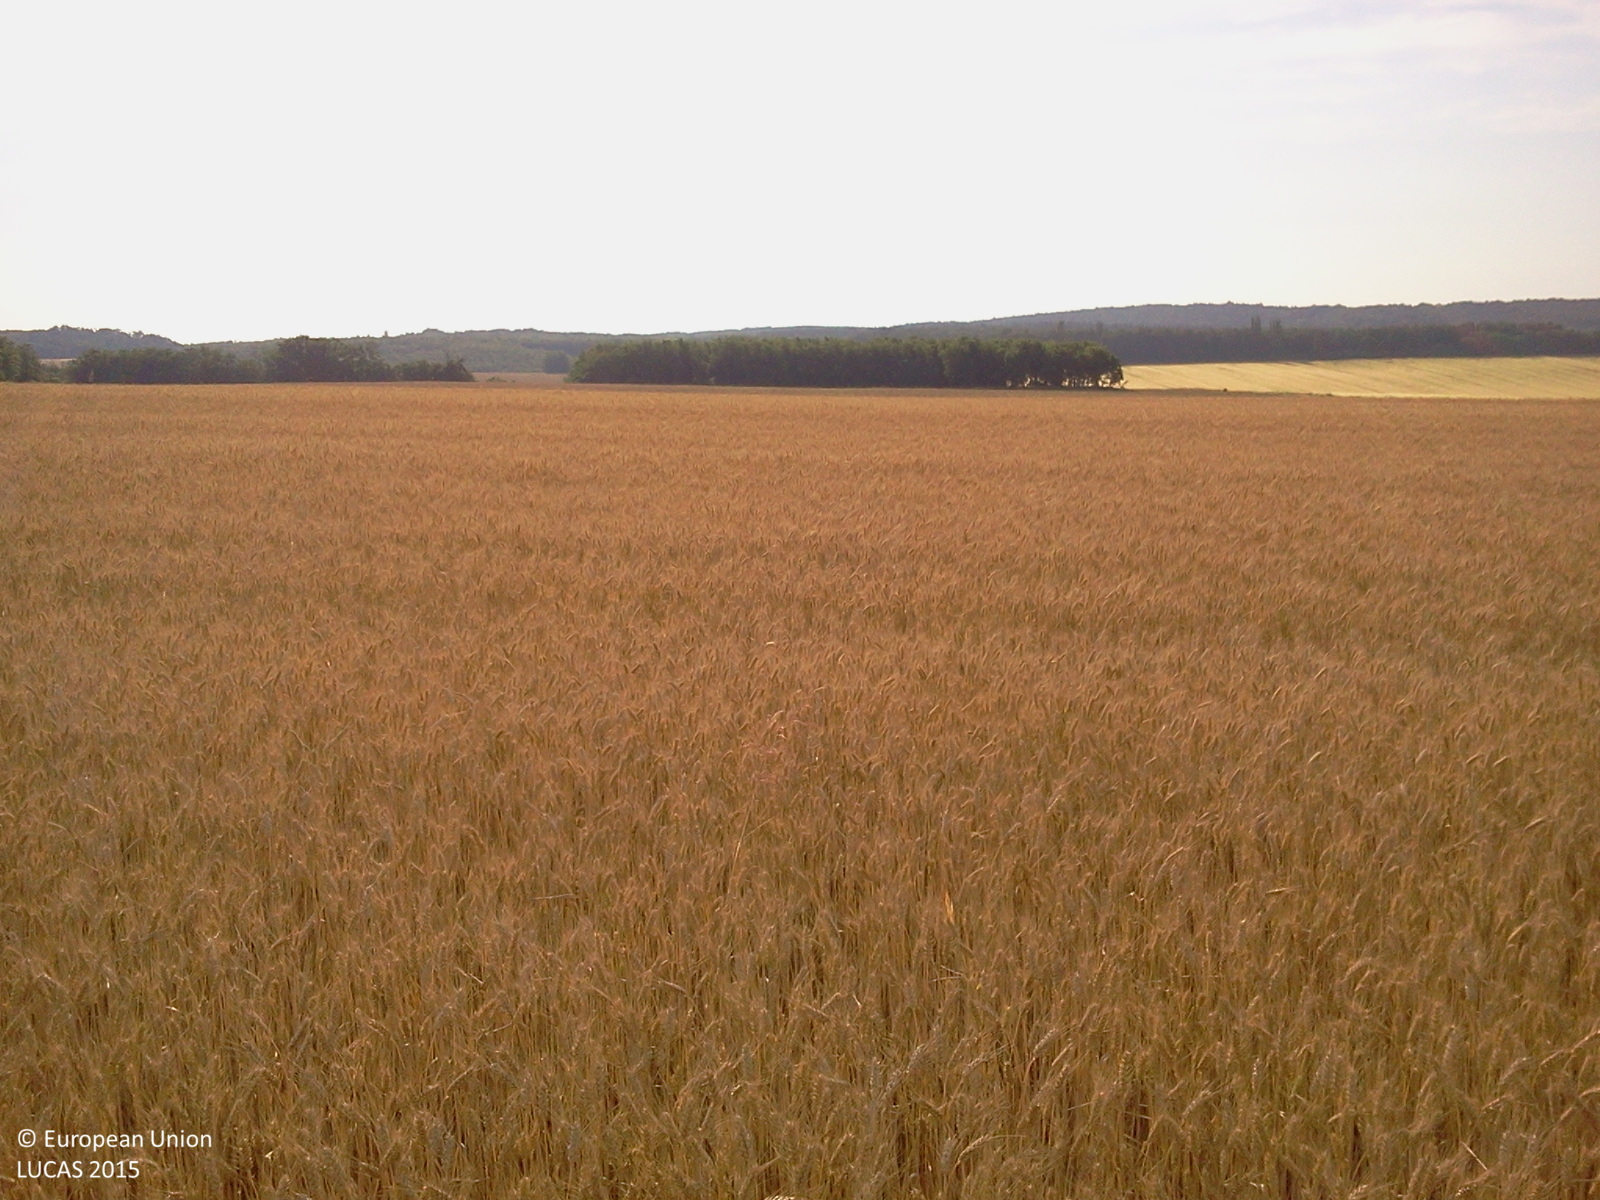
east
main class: Cropland
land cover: Common wheat
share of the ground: > 75 %
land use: Agriculture (excluding fallow land and kitchen gardens)
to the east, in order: Common wheat
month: June
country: HU
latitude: 46.6822
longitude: 16.9980
